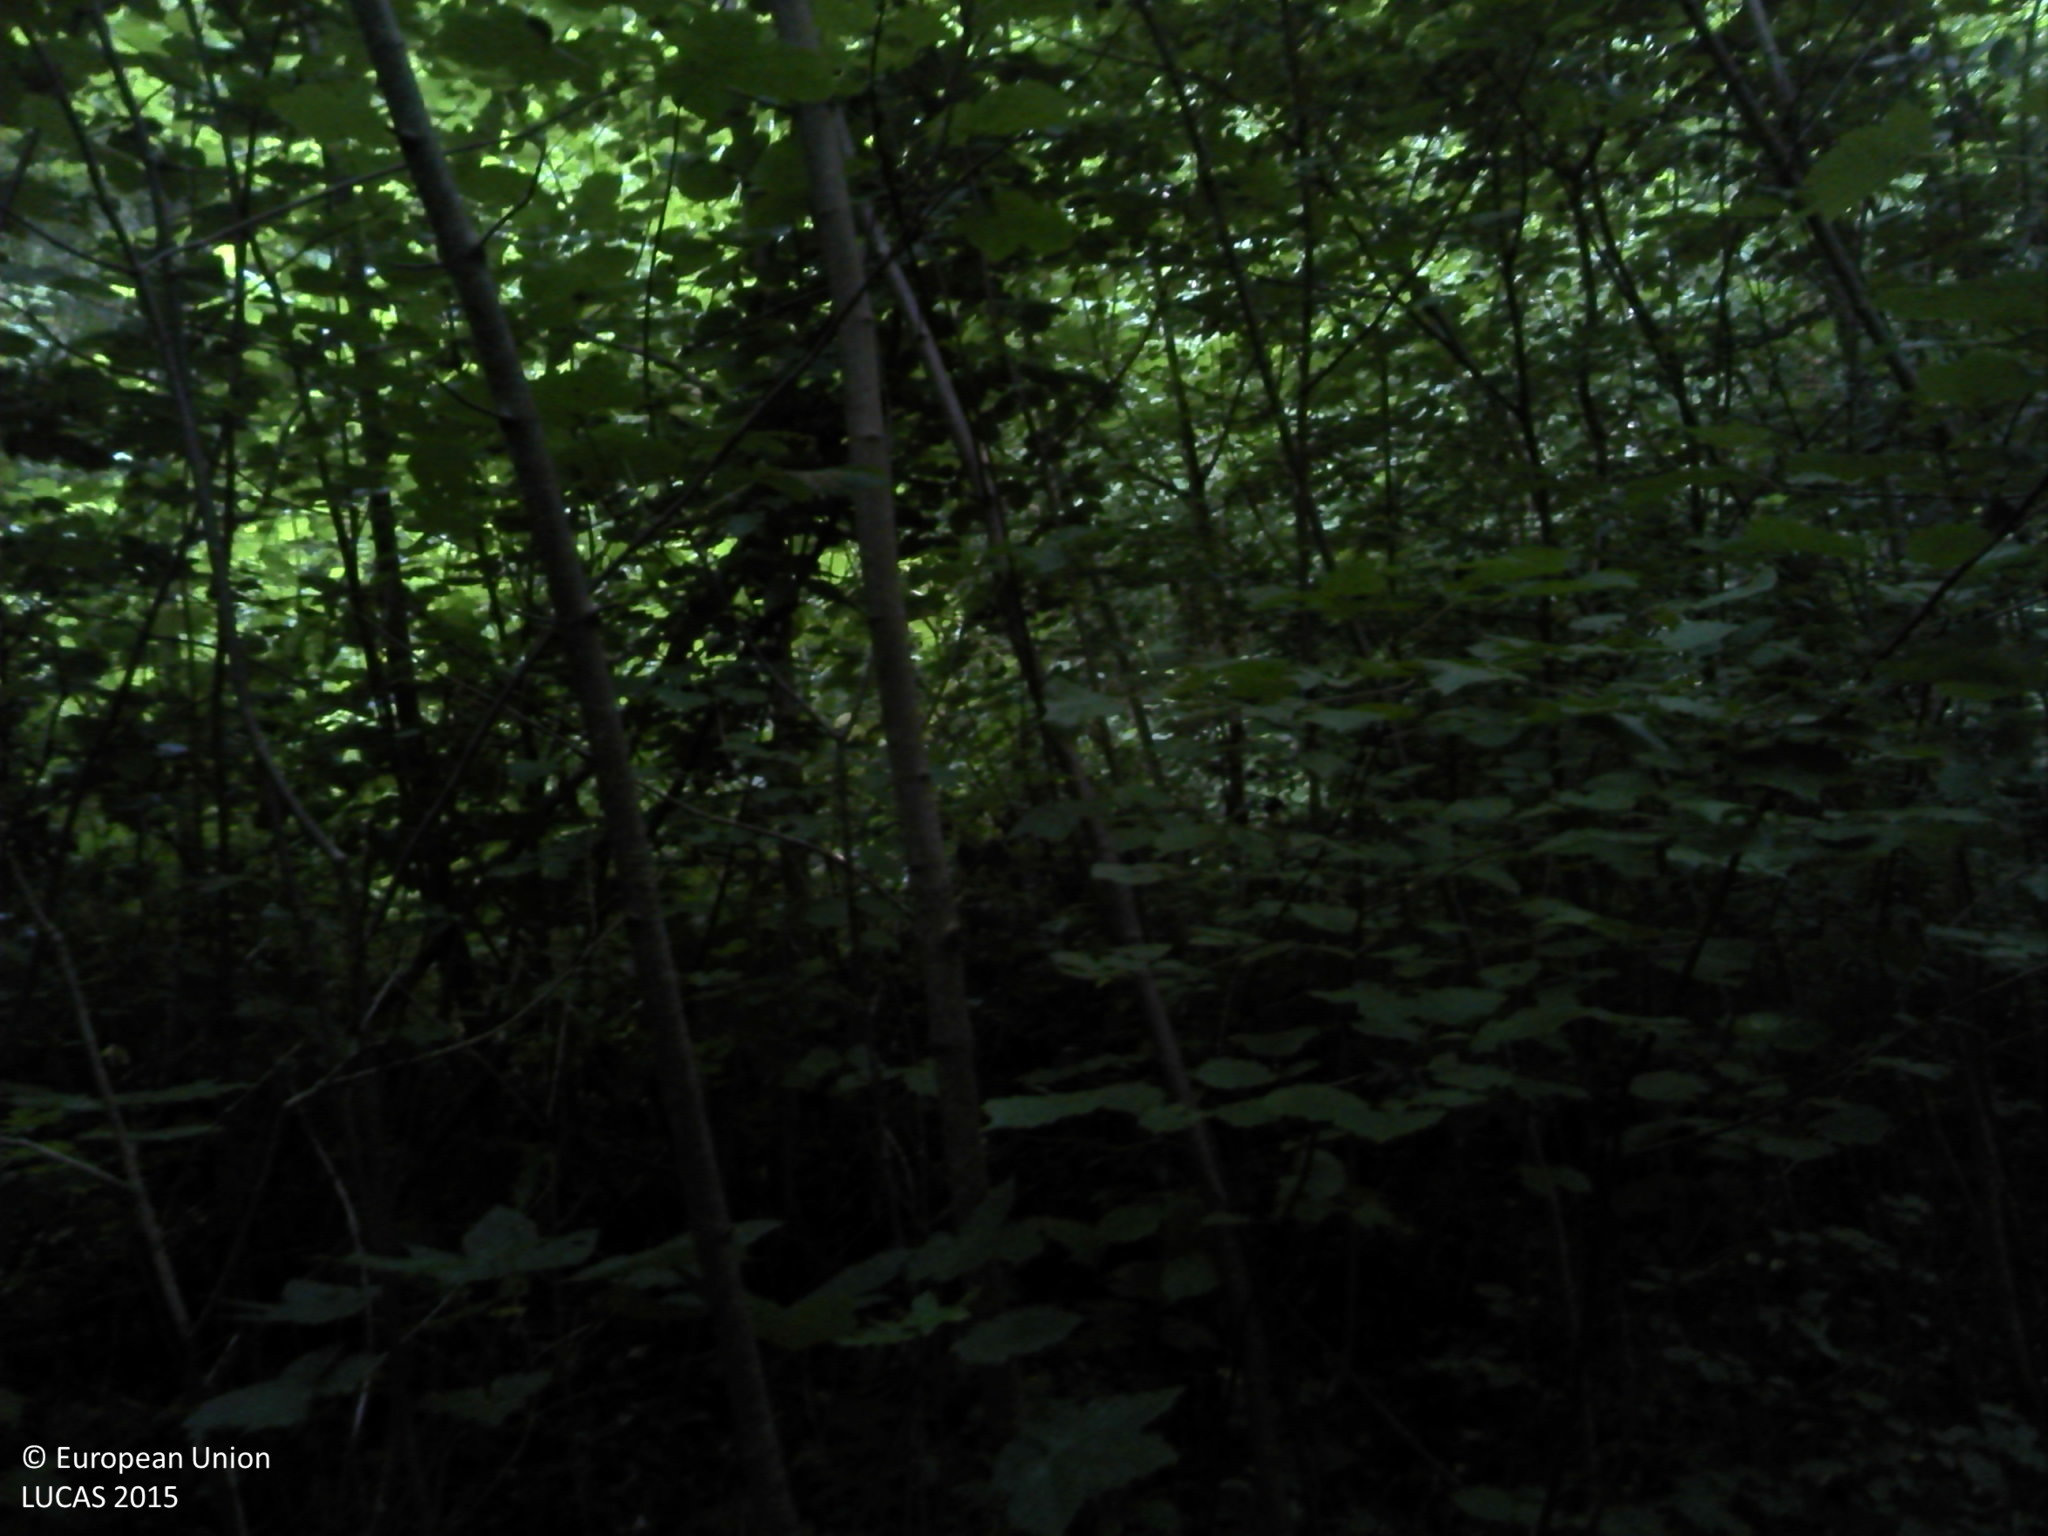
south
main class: Woodland
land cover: Broadleaved woodland
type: beech forest
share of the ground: > 75 %
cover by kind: broadleaved forest trees 80 %, consolidated bare surface 15 %, herbaceous plants 5 %
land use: Forestry
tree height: > 5 m
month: July
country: FR
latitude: 49.6728
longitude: 4.4949
